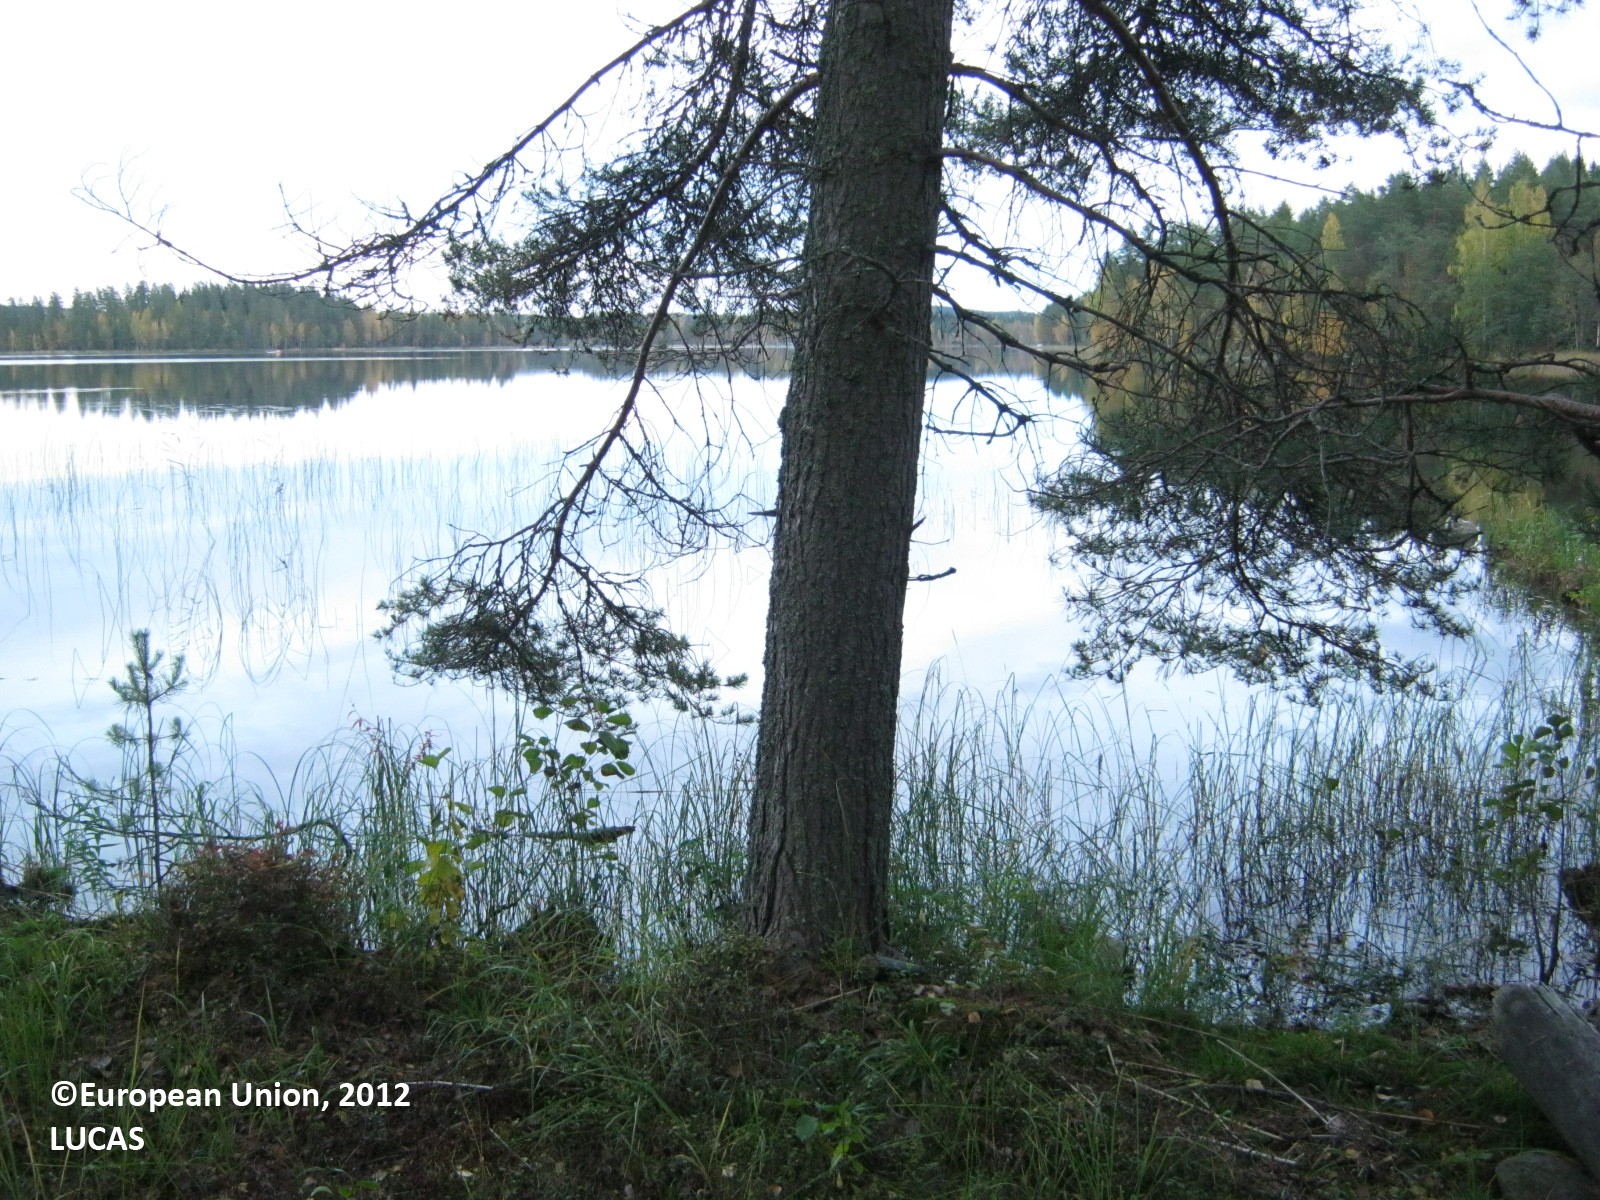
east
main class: Woodland
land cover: Other mixed woodland
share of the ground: 25 - 50 %
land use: Residential
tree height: > 5 m
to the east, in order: Other mixed woodland; Inland water bodies
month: September
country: FI
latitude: 62.3283
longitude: 28.7617
